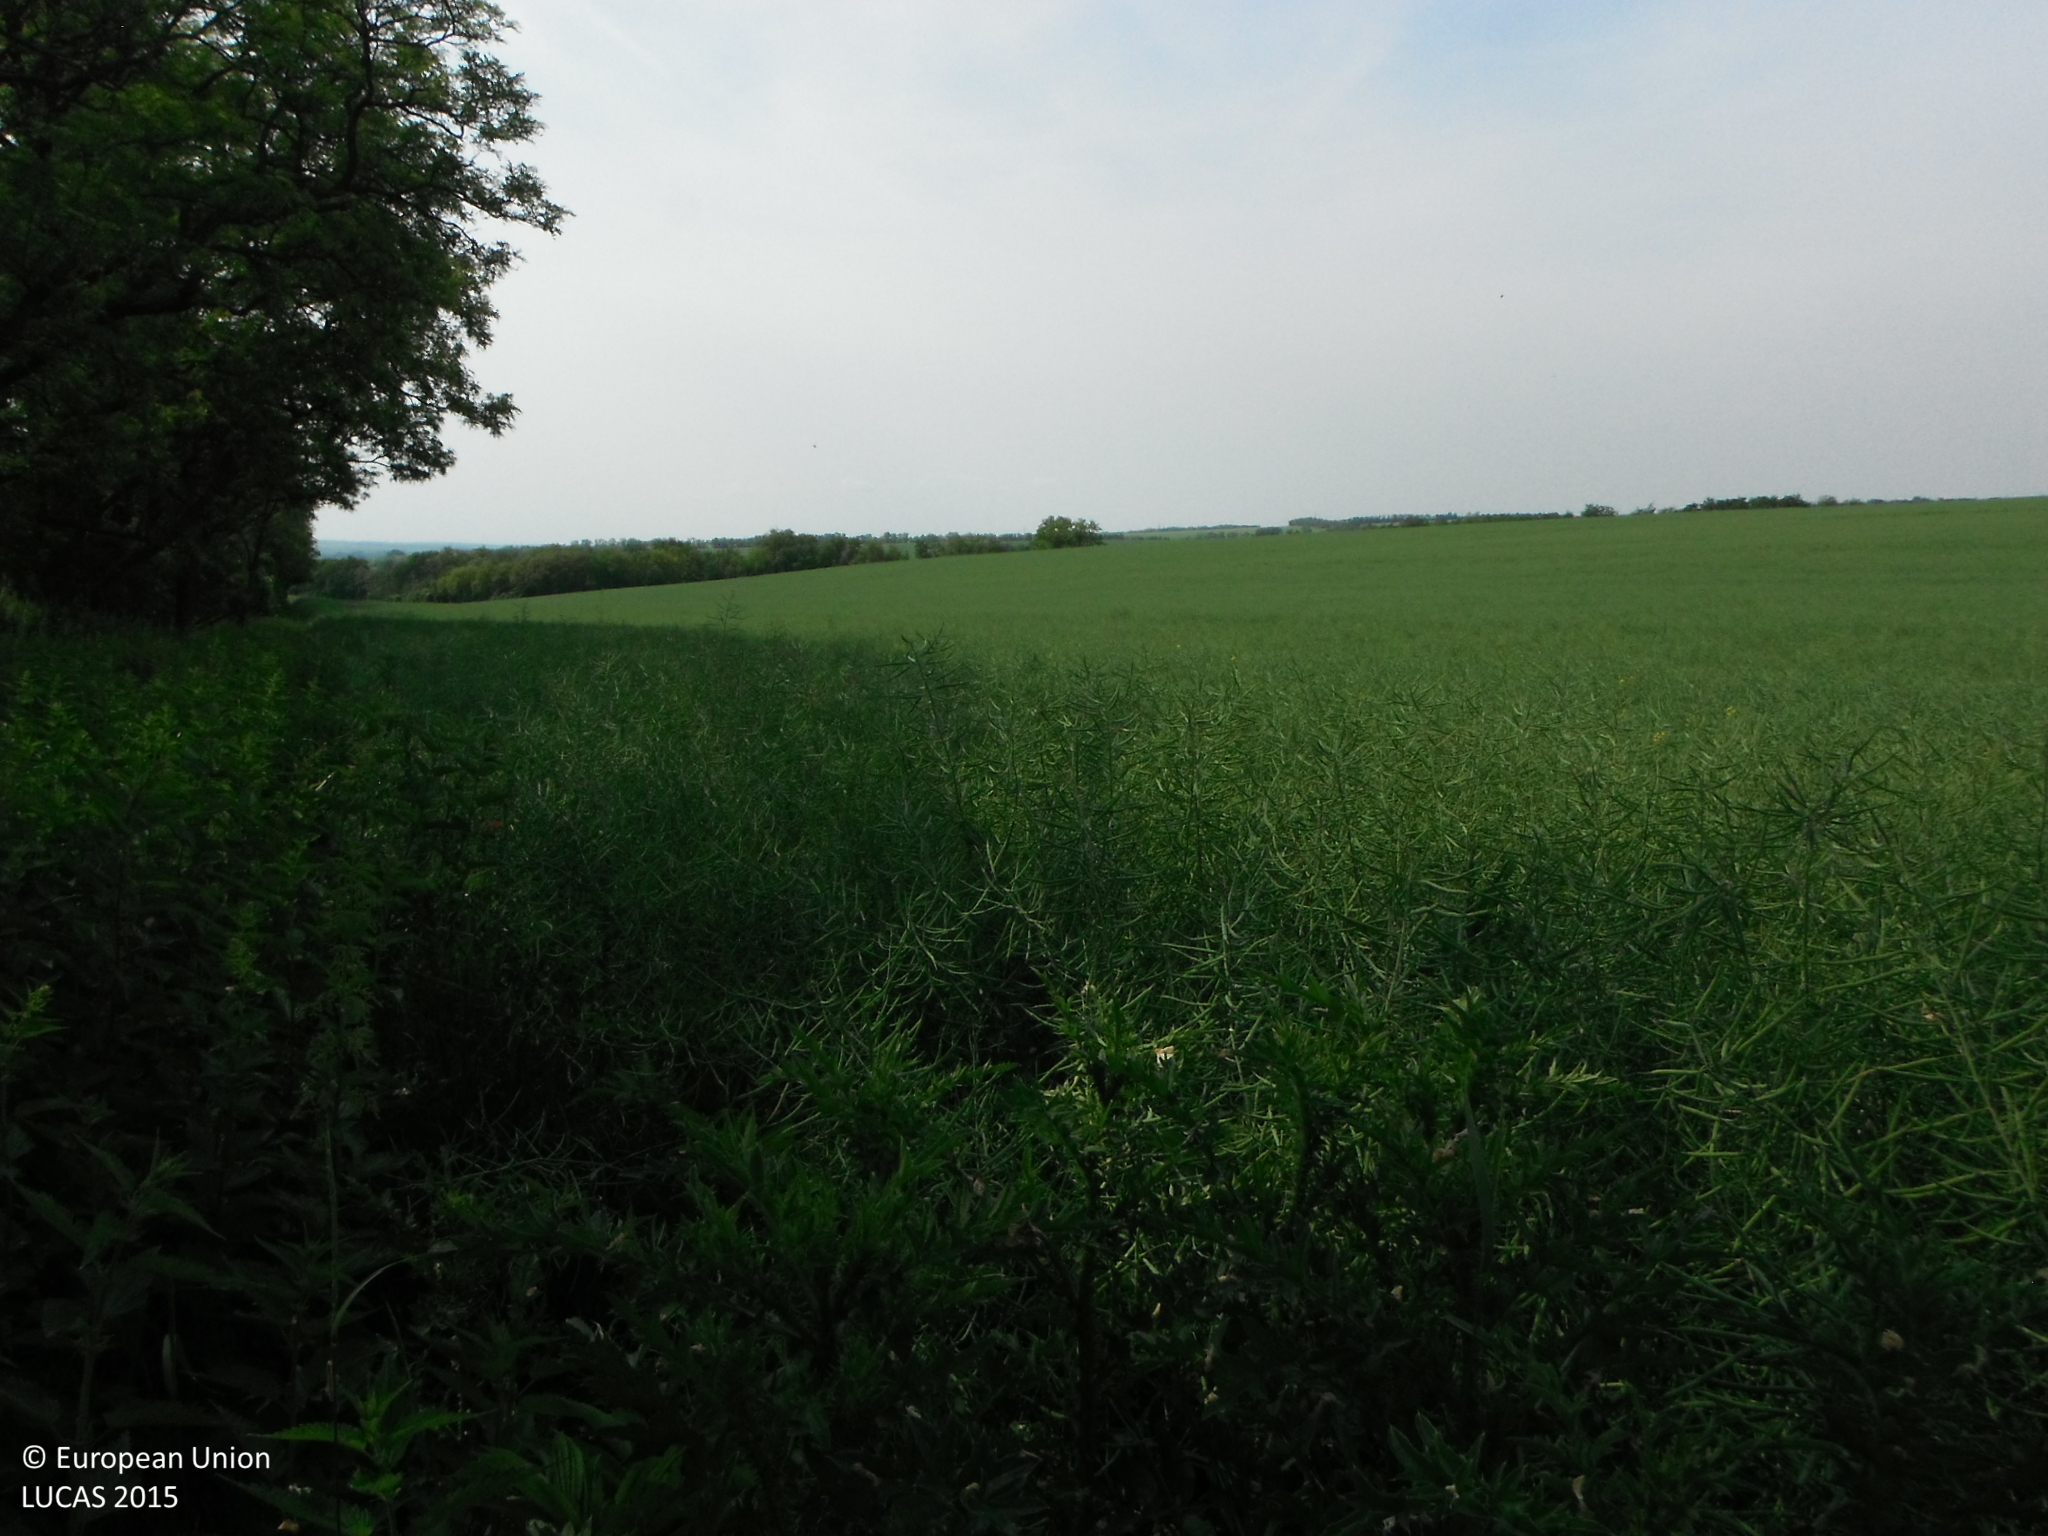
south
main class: Cropland
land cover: Rape and turnip rape
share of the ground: > 75 %
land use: Agriculture (excluding fallow land and kitchen gardens)
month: June
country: SK
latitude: 48.2381
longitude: 18.2684
